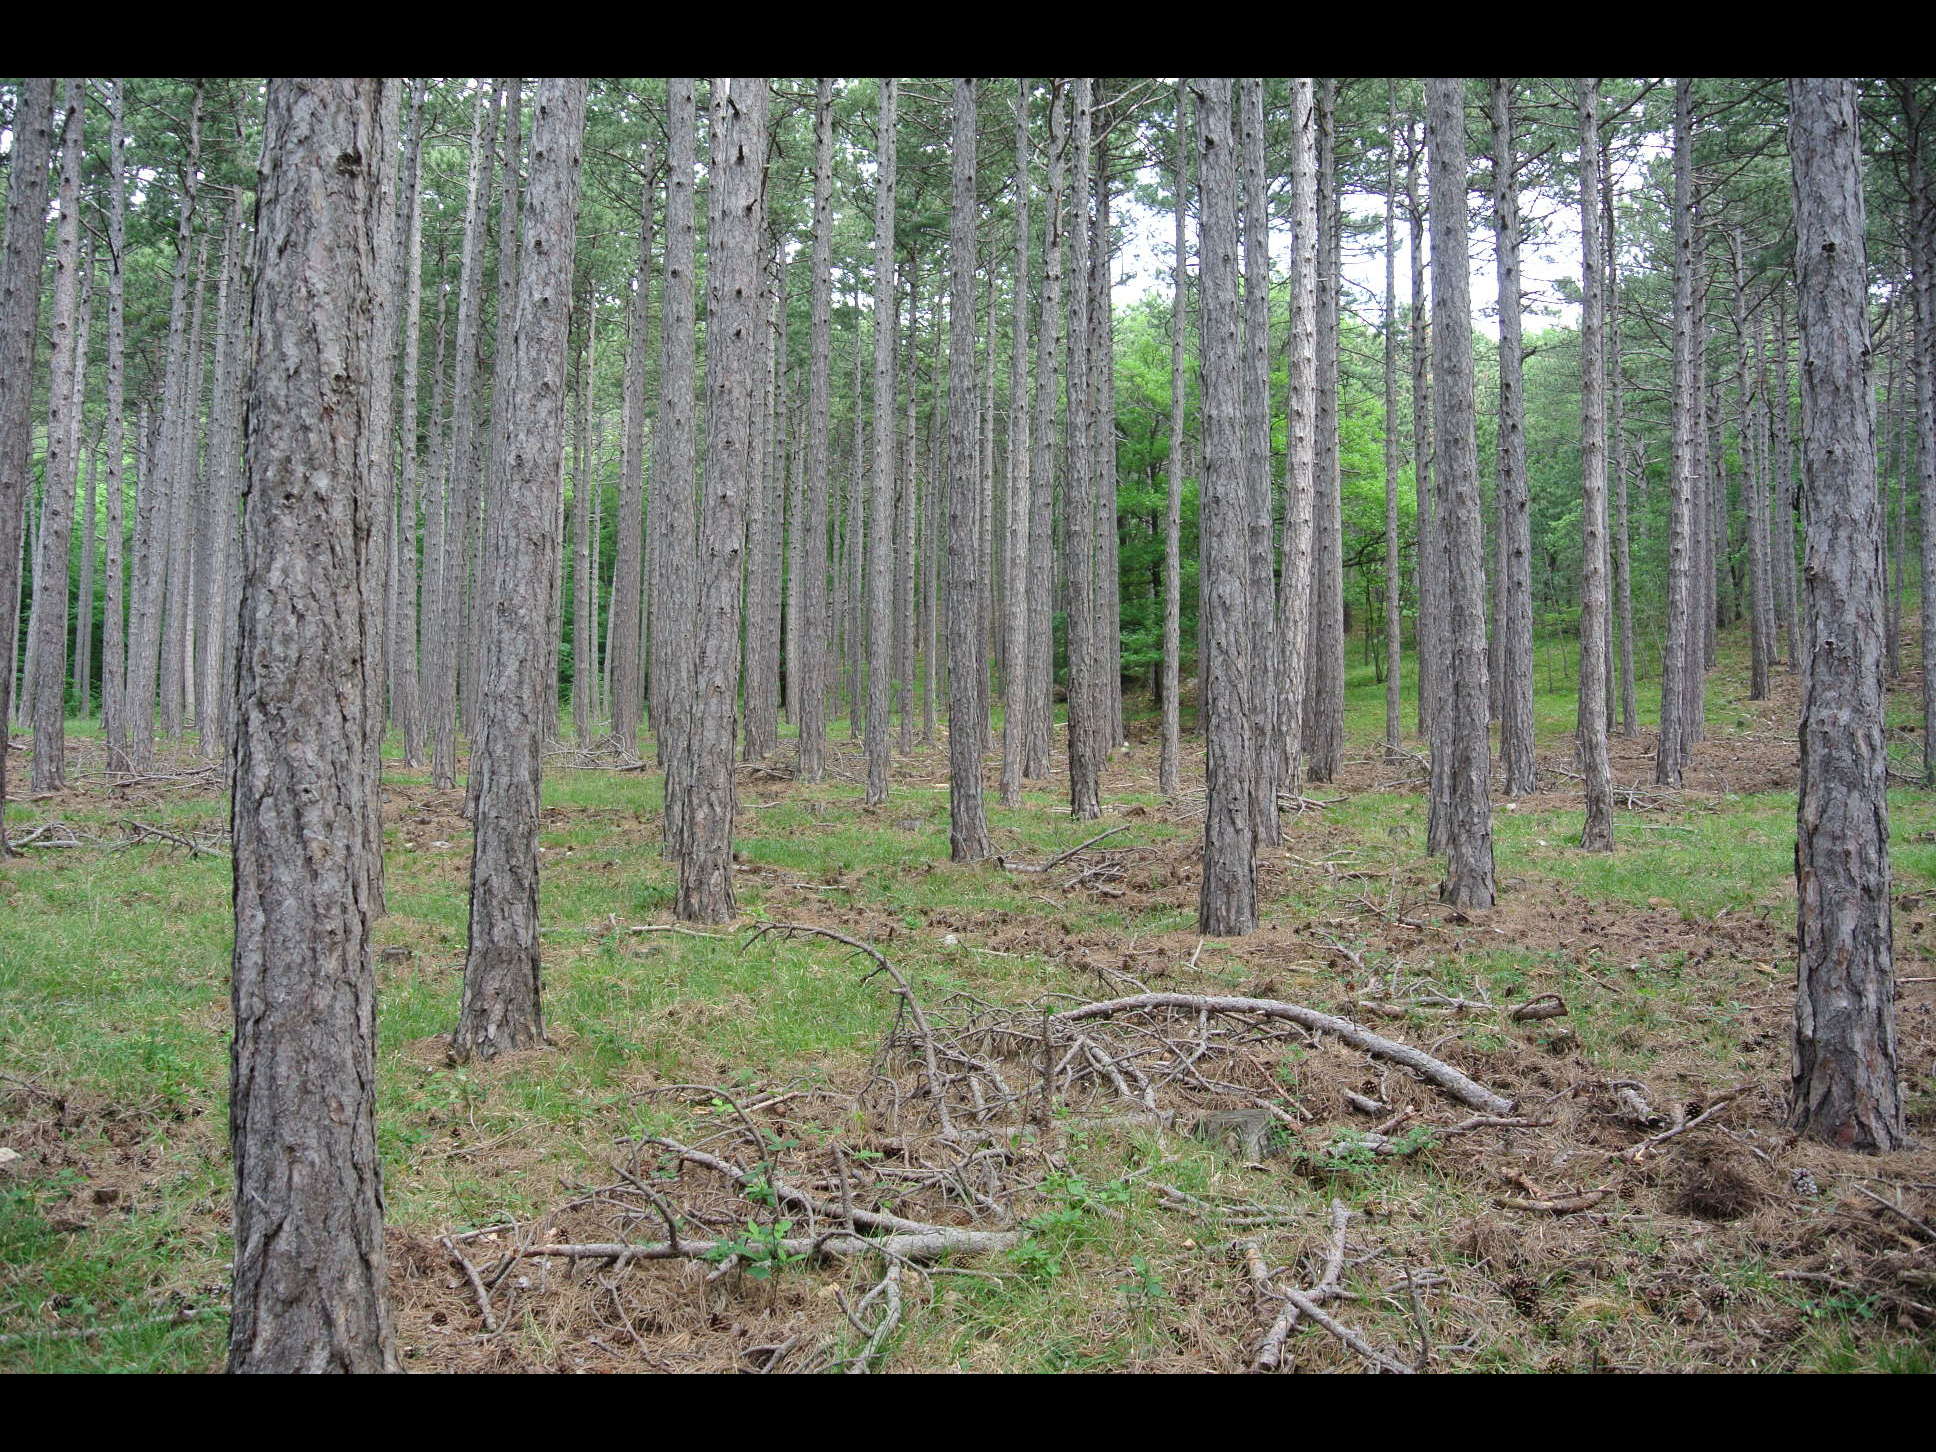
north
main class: Woodland
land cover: Pine dominated coniferous woodland
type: alpine coniferous forest
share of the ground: > 75 %
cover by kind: coniferous forest trees 85 %, herbaceous plants 15 %
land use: Forestry
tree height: > 5 m
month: May
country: AT
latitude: 47.8196
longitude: 16.1071
